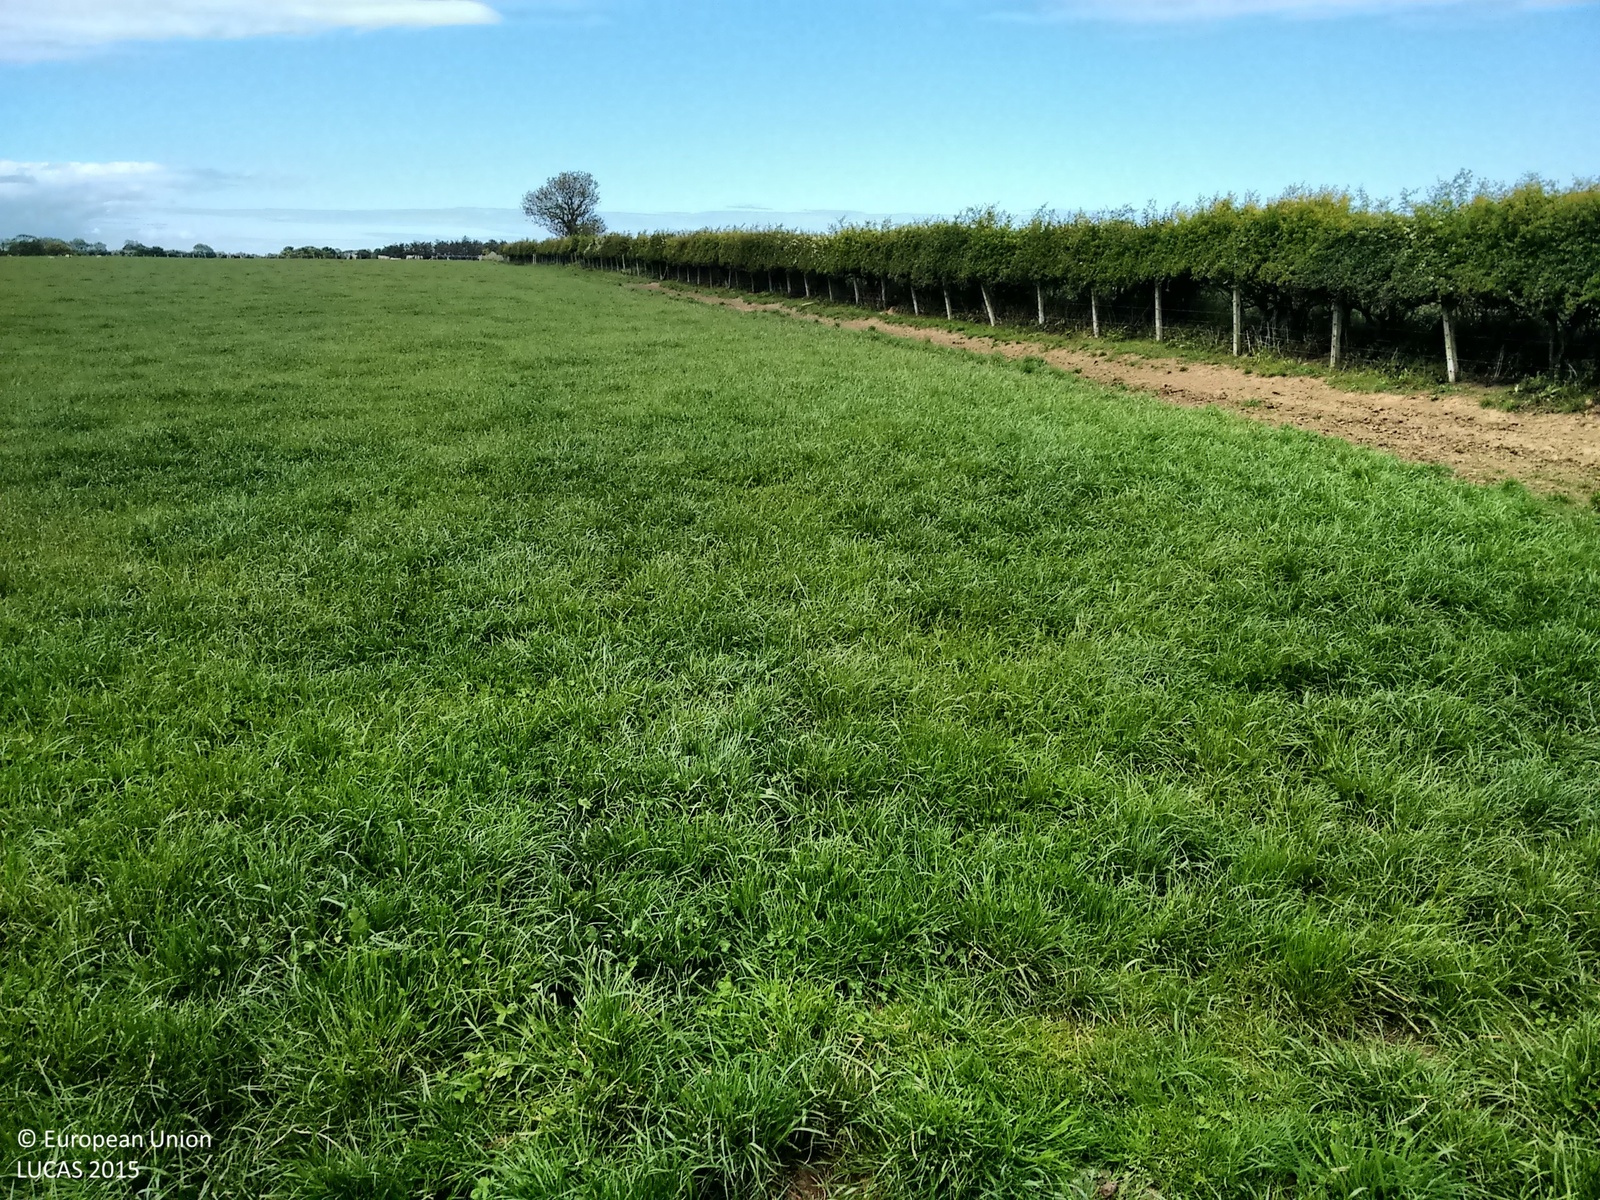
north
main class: Cropland
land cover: Temporary grasslands
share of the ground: > 75 %
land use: Agriculture (excluding fallow land and kitchen gardens)
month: June
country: GB
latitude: 55.5622
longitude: -1.6703
